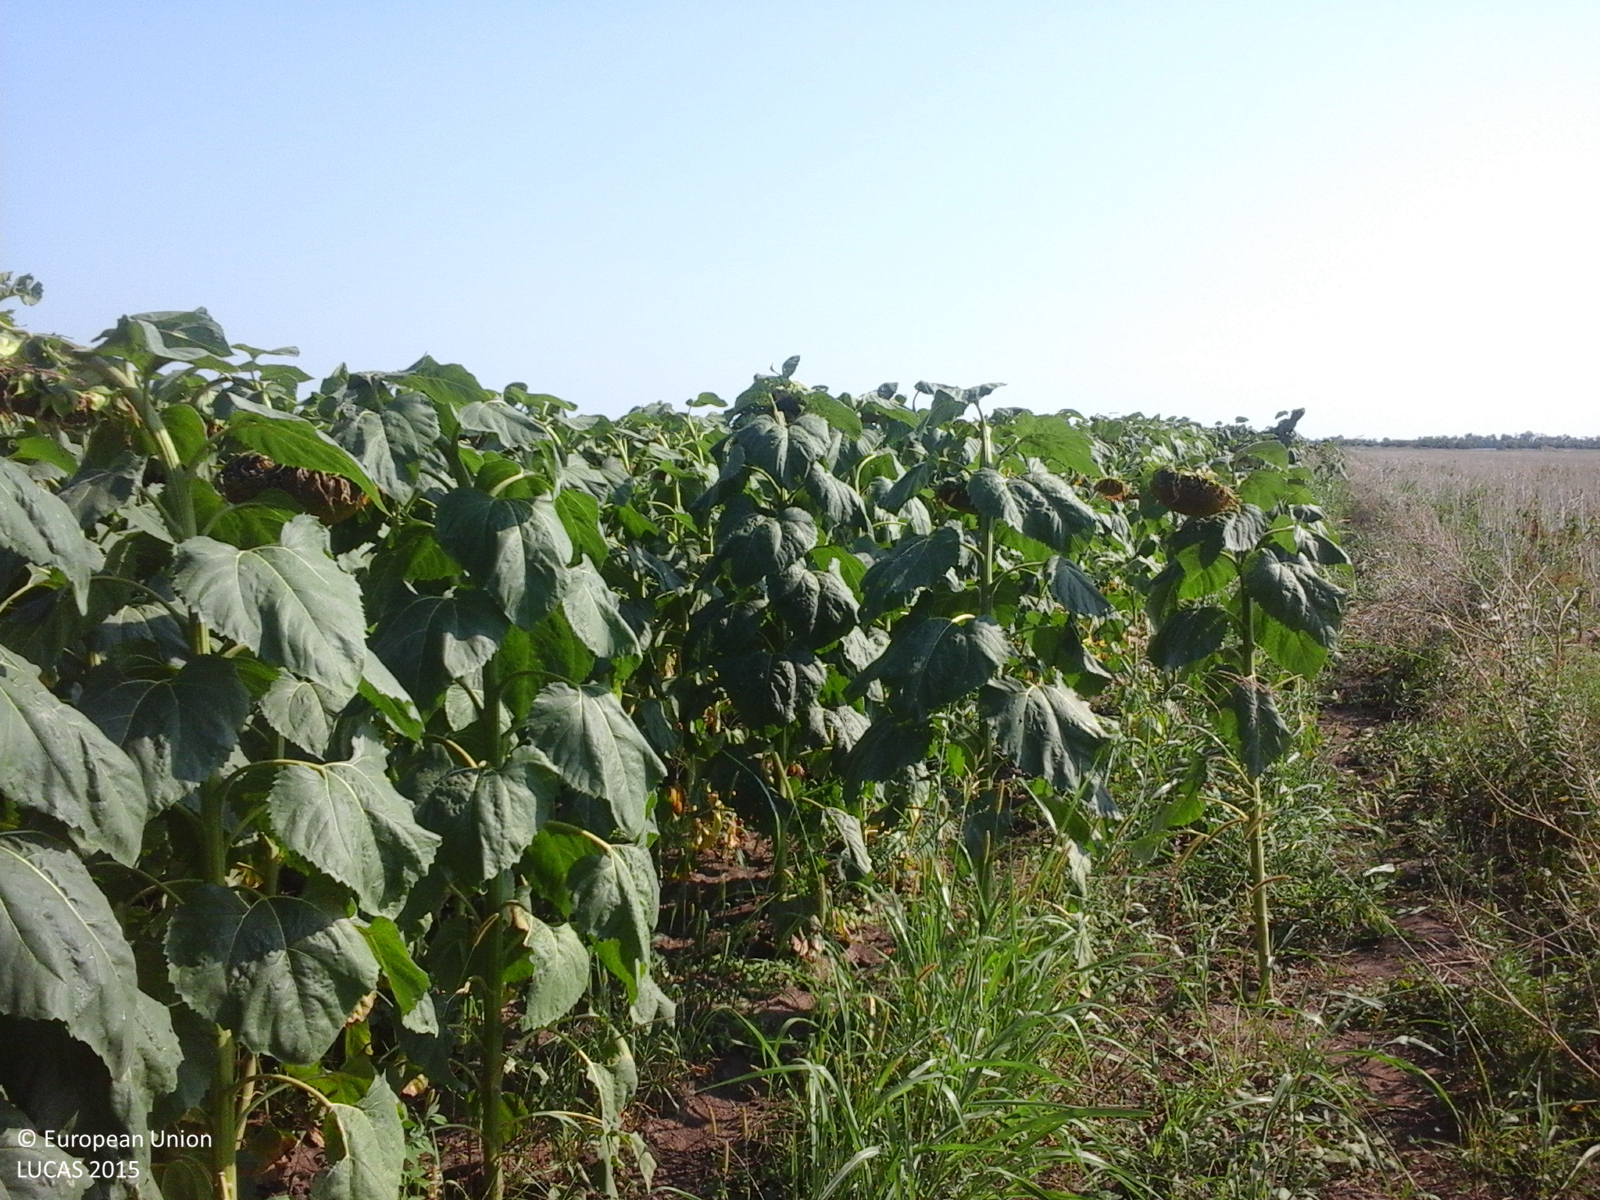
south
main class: Cropland
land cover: Sunflower
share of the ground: > 75 %
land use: Agriculture (excluding fallow land and kitchen gardens)
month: July
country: RO
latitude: 44.8810
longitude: 27.1387
